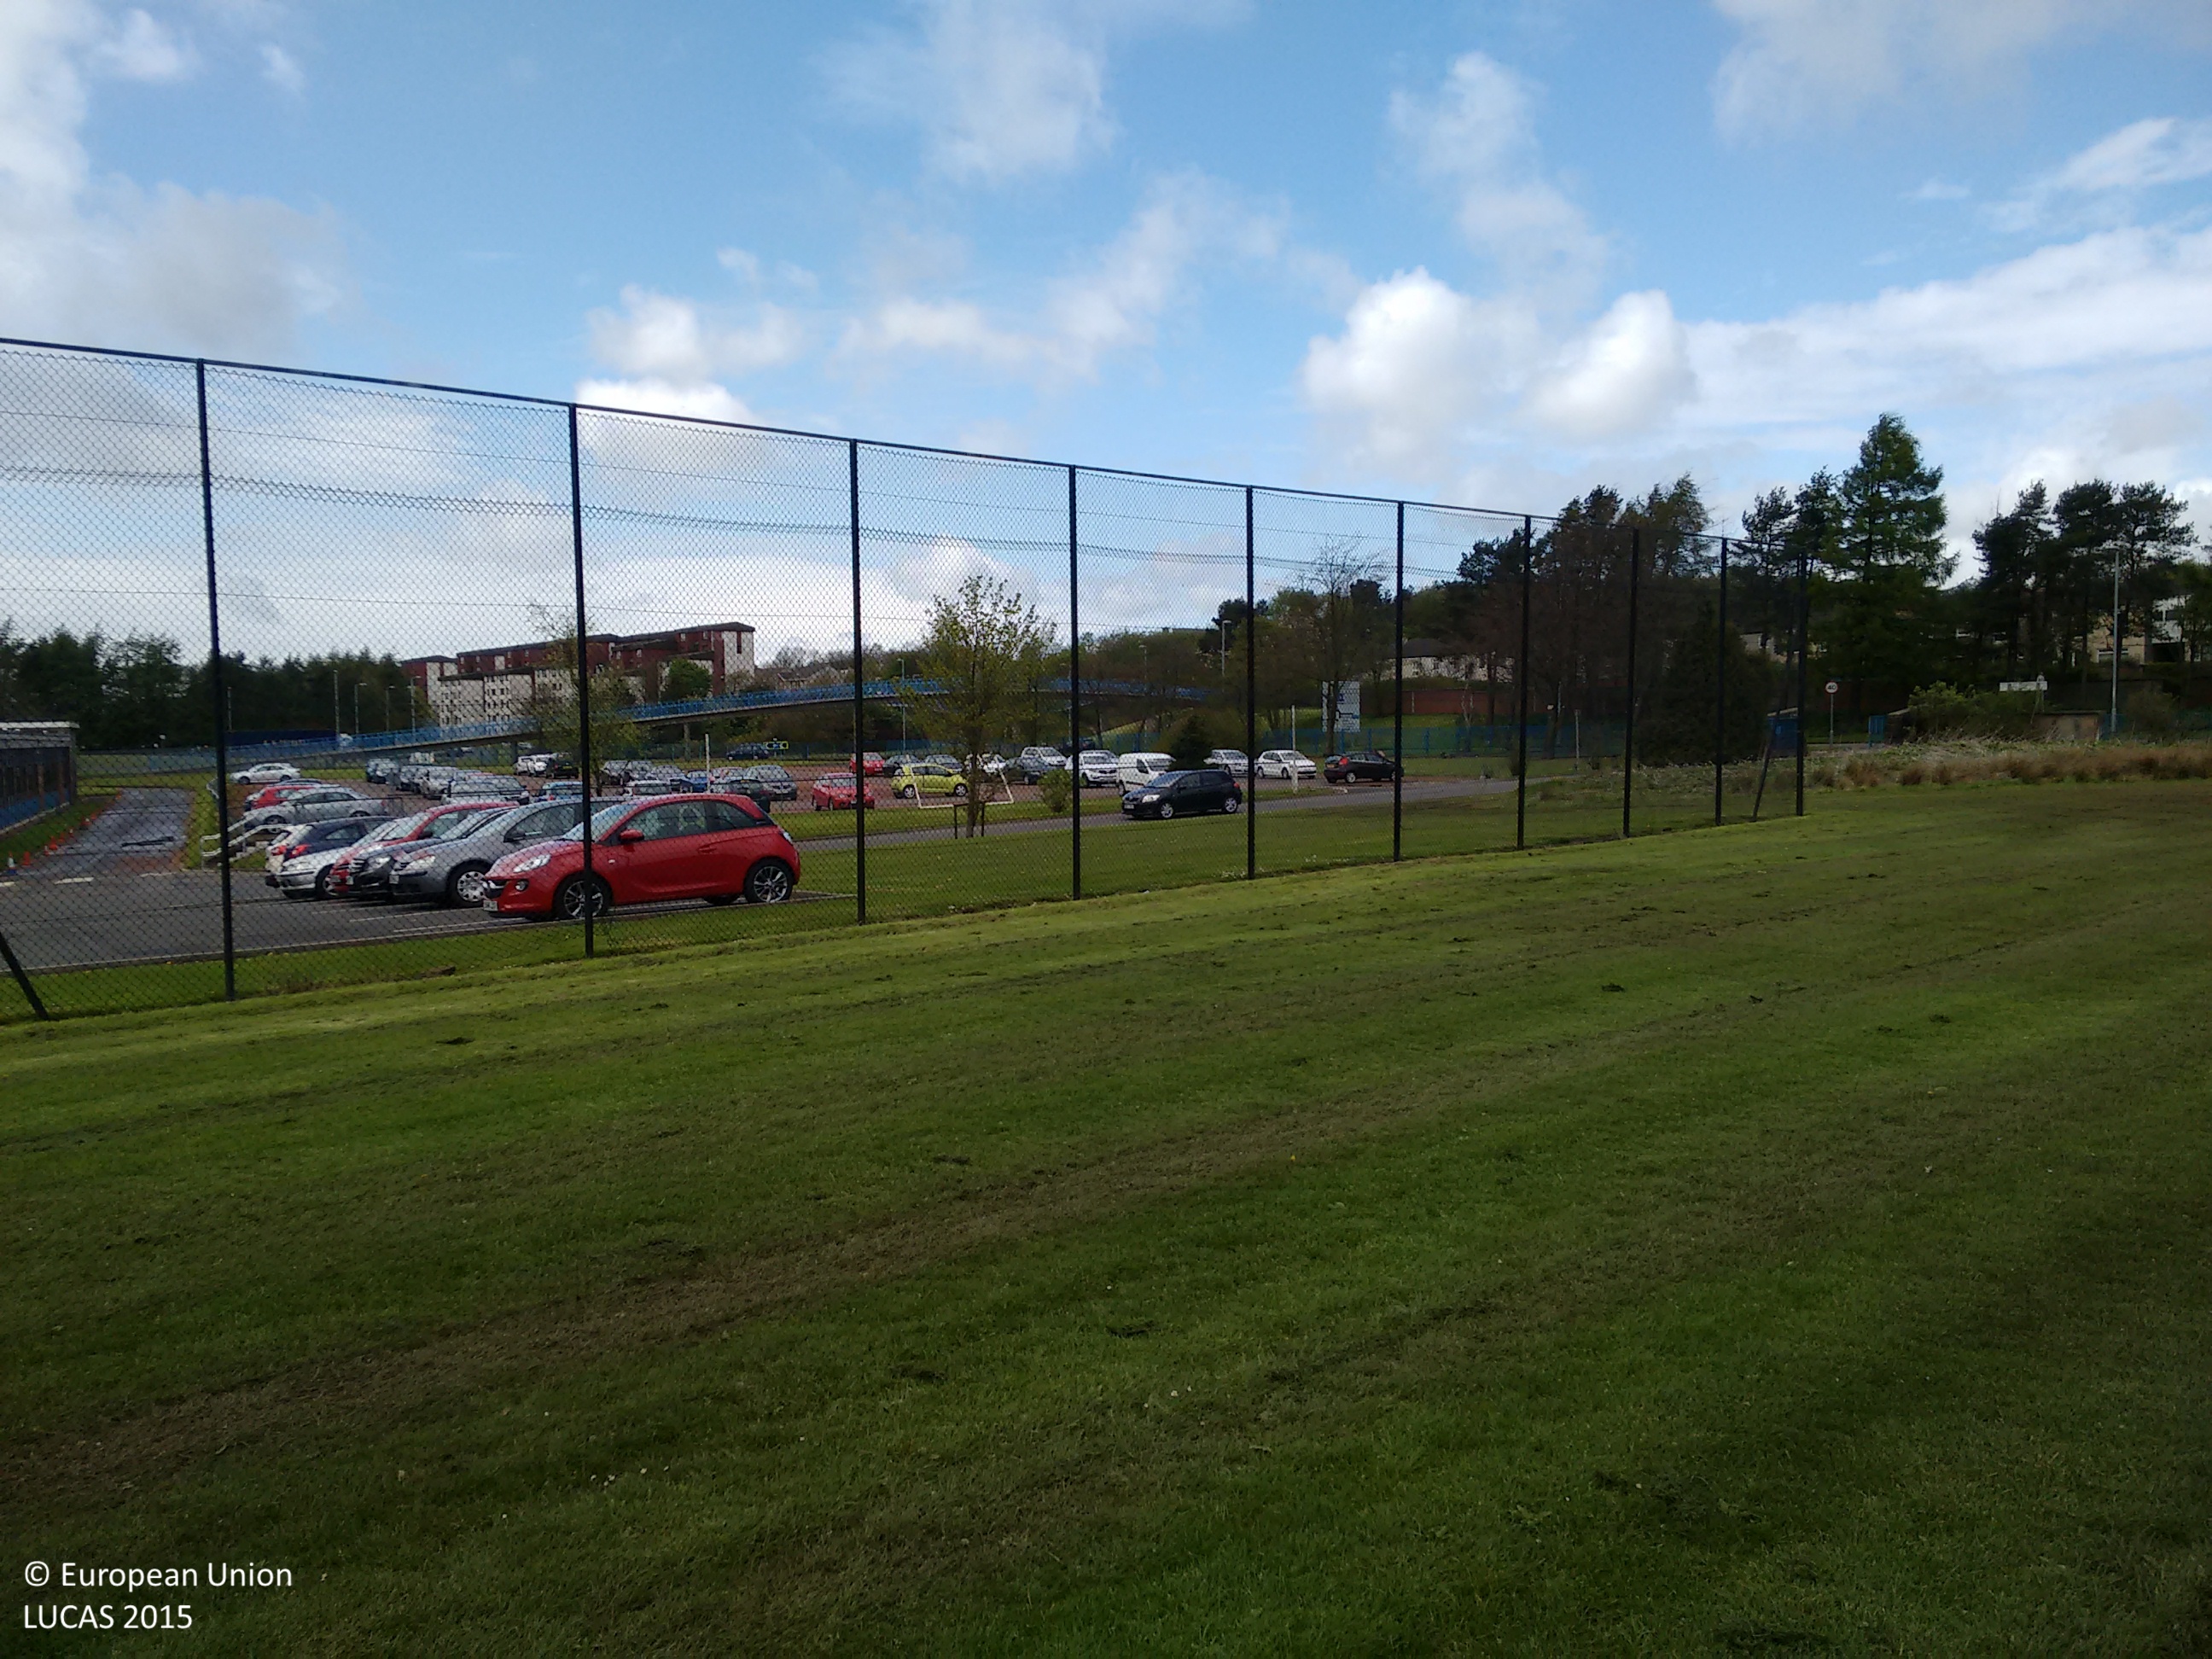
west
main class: Grassland
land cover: Grassland without tree/shrub cover
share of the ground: > 75 %
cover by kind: herbaceous plants 100 %
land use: Sport
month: May
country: GB
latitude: 55.9484
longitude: -3.9705
